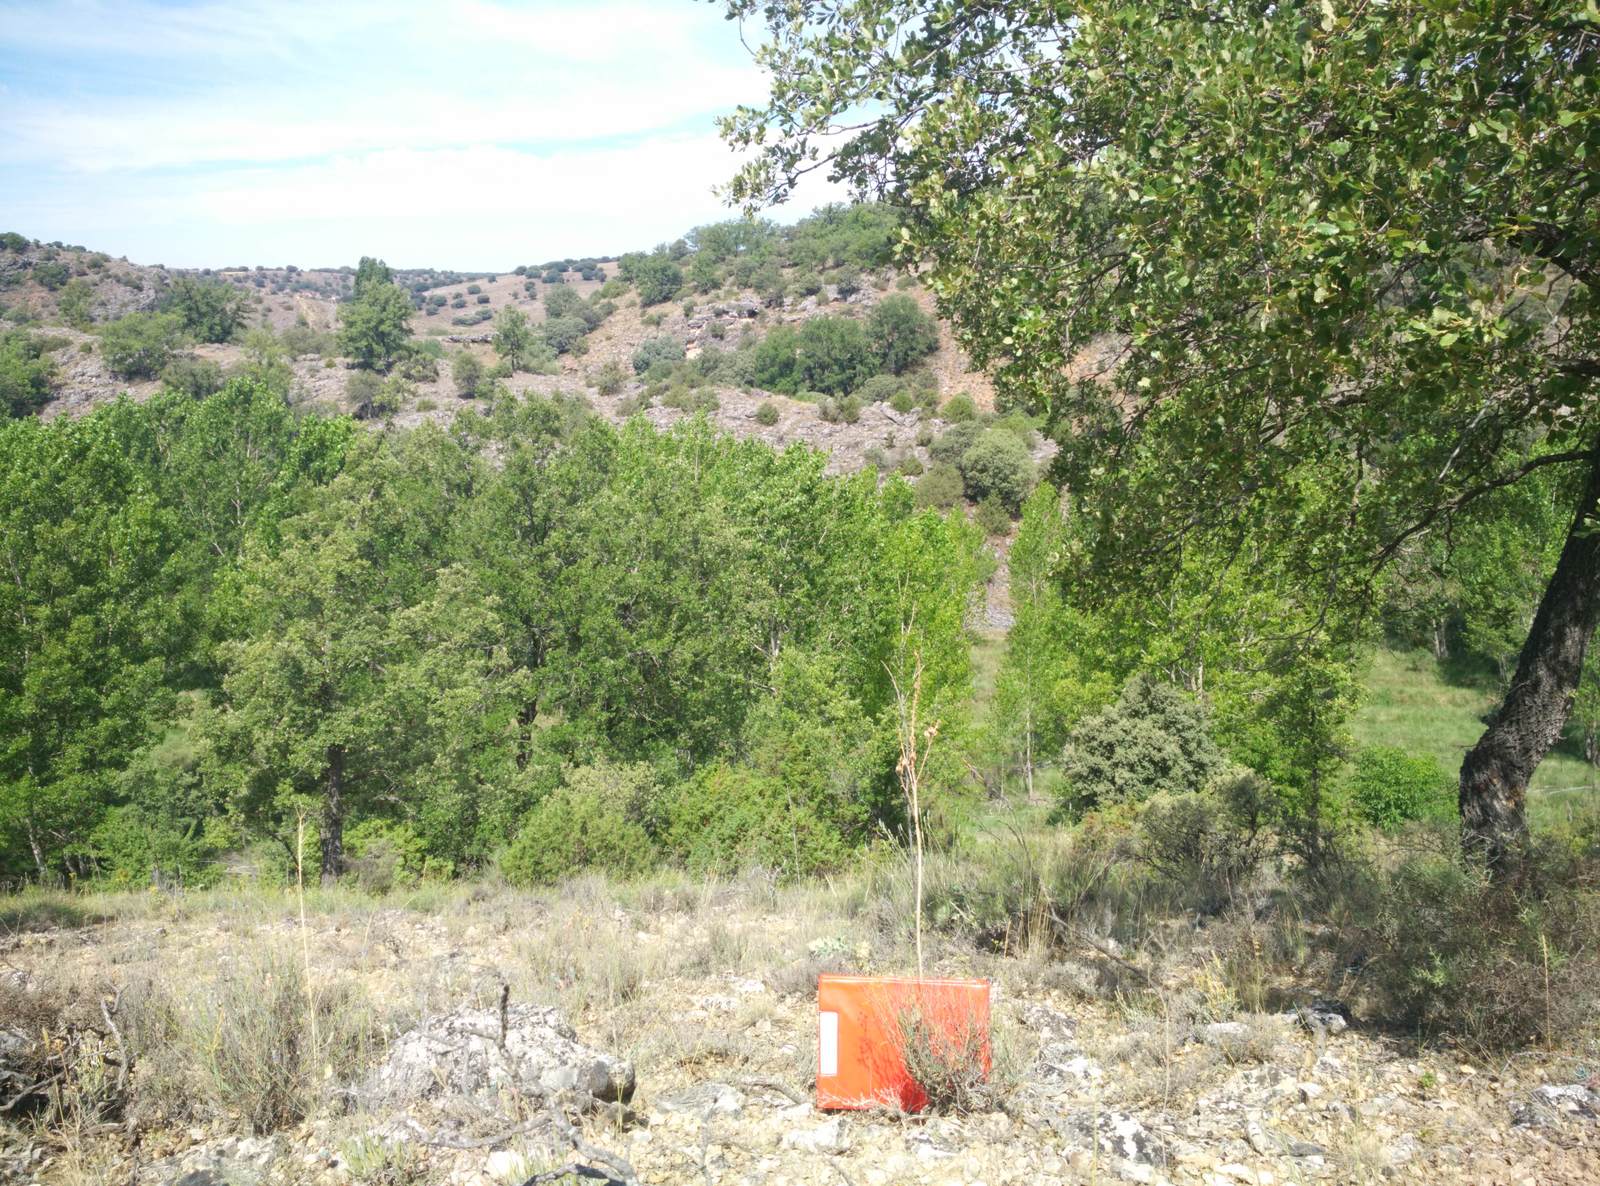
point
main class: Shrubland
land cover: Shrubland with sparse tree cover
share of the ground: 50 - 75 %
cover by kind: shrubs 50 %, unconsolidated bare surface 40 %, broadleaved forest trees 5 %, herbaceous plants 5 %
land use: Semi-natural and natural areas not in use
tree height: < 5 m
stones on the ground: > 50 %
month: July
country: ES
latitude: 40.8927
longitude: -2.6235
